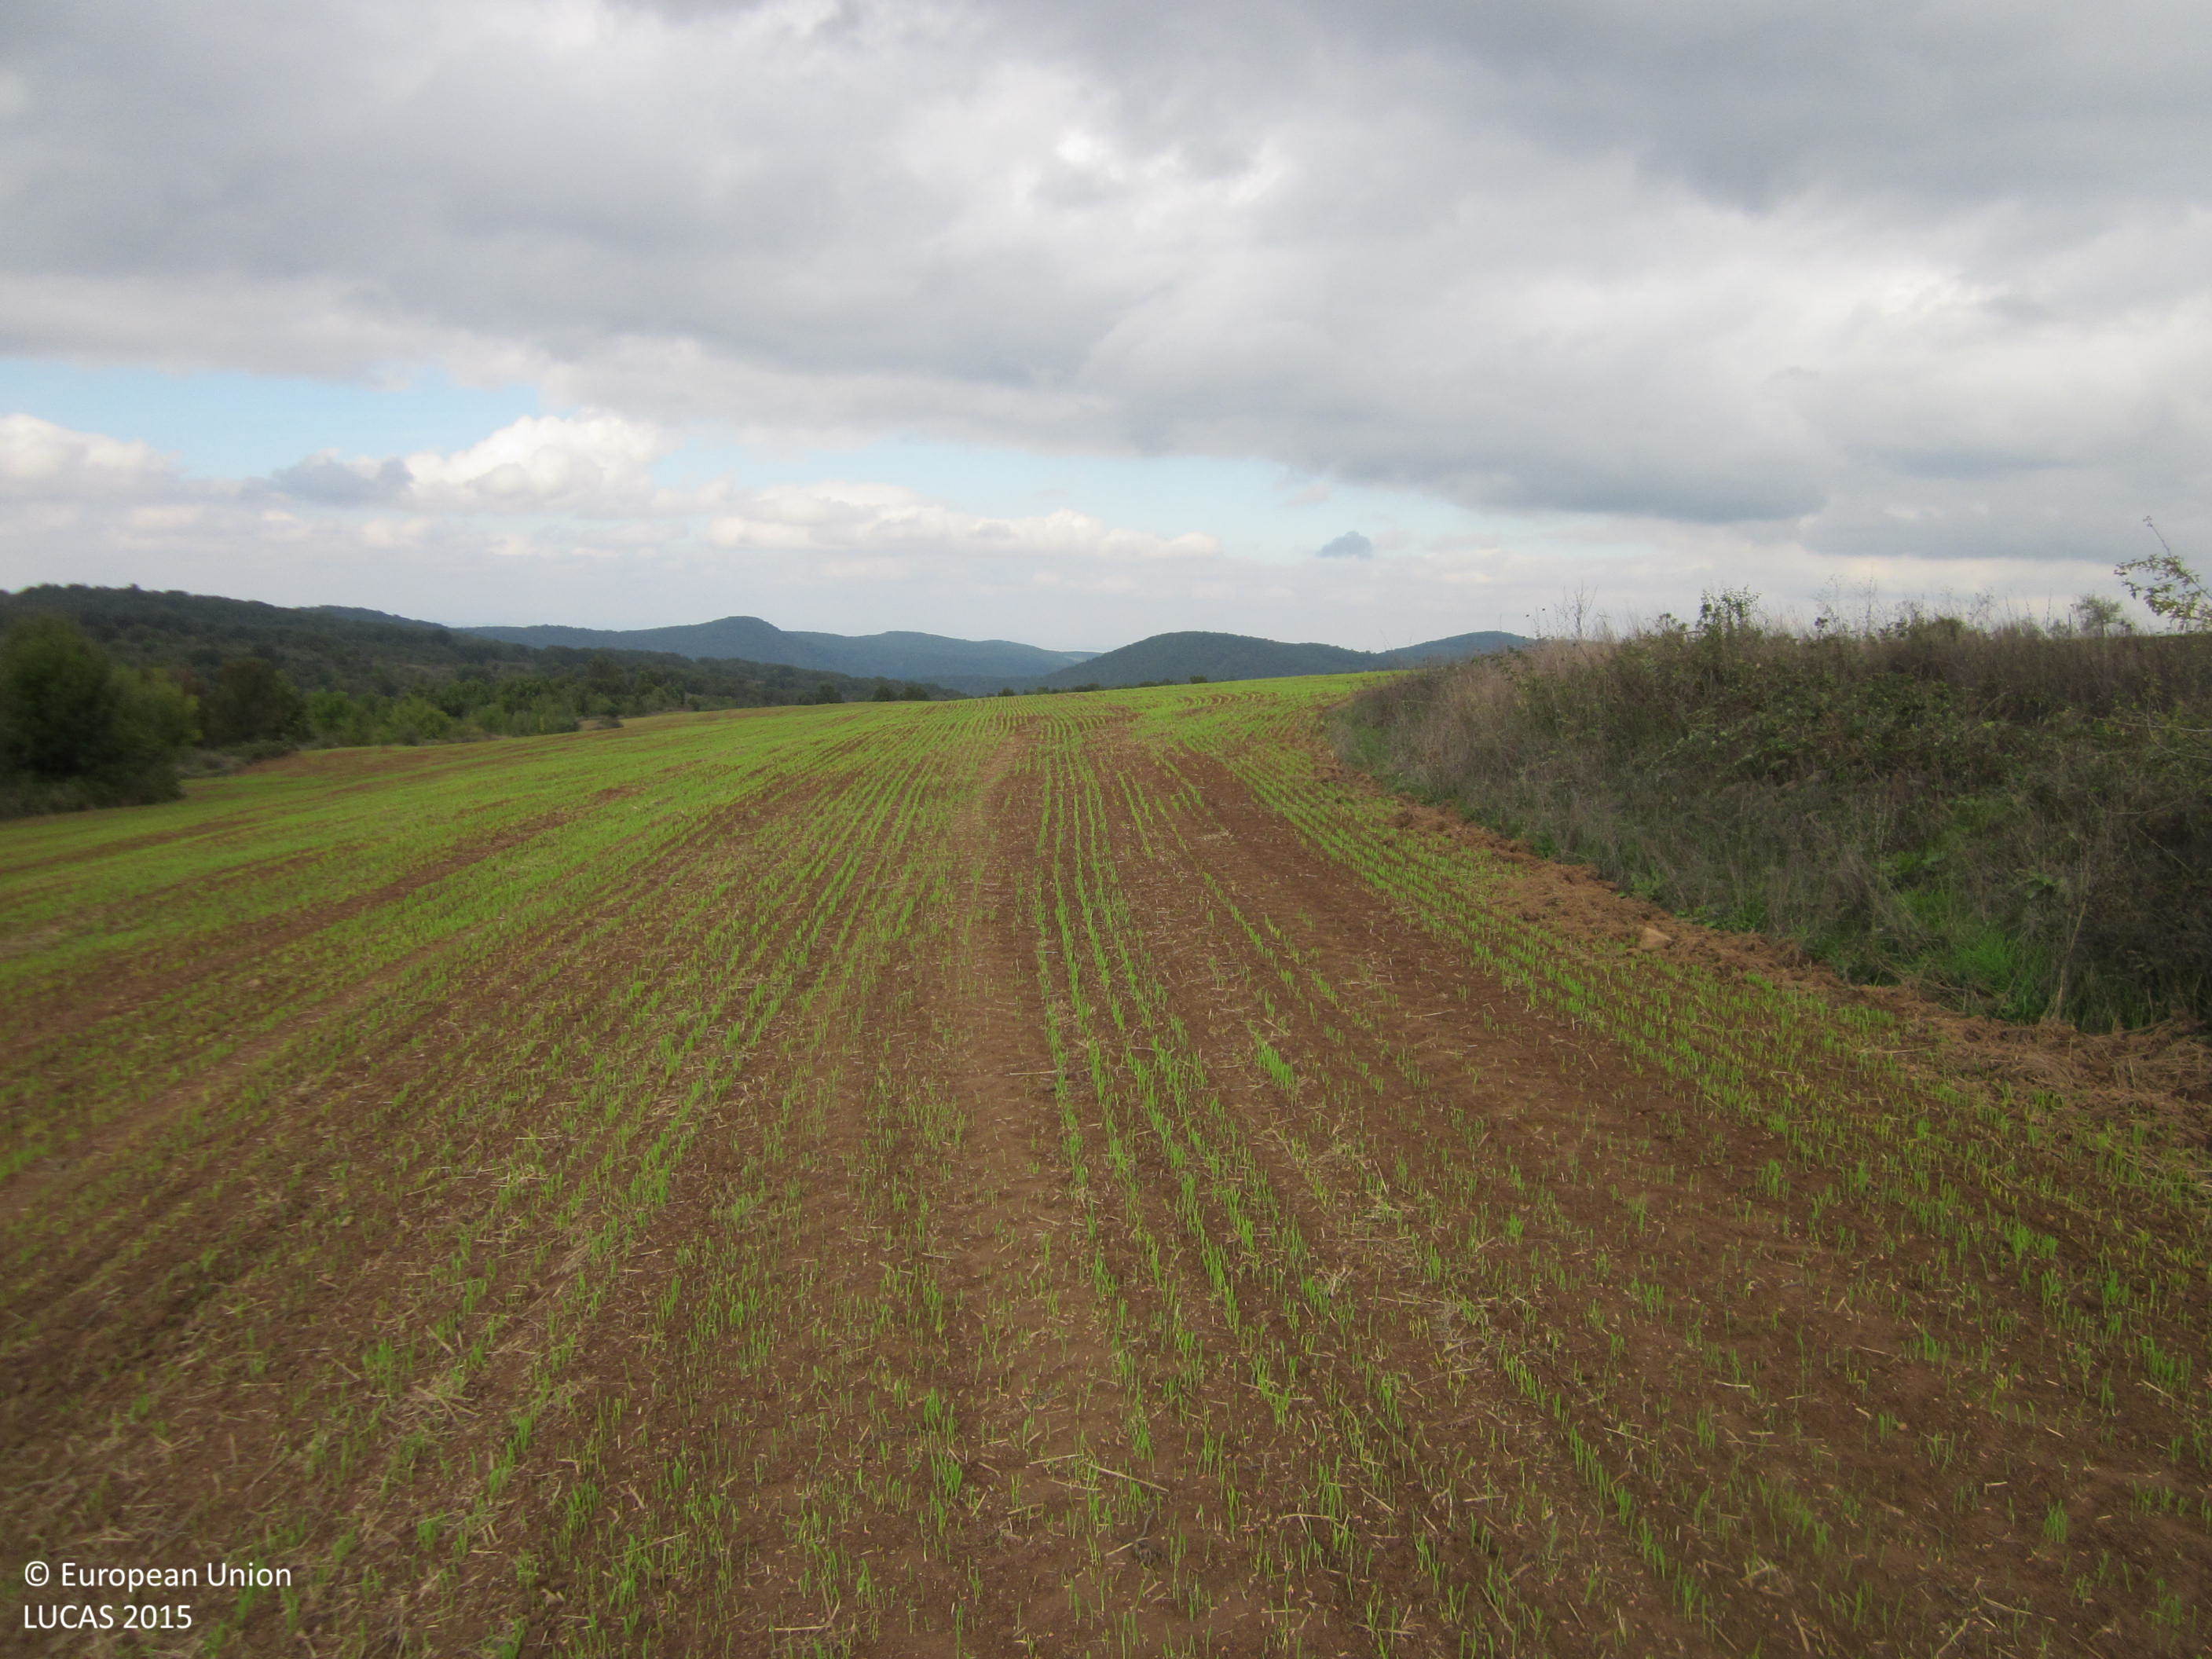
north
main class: Cropland
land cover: Common wheat
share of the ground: 10 - 25 %
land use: Agriculture (excluding fallow land and kitchen gardens)
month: October
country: BG
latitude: 42.2466
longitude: 27.2572
